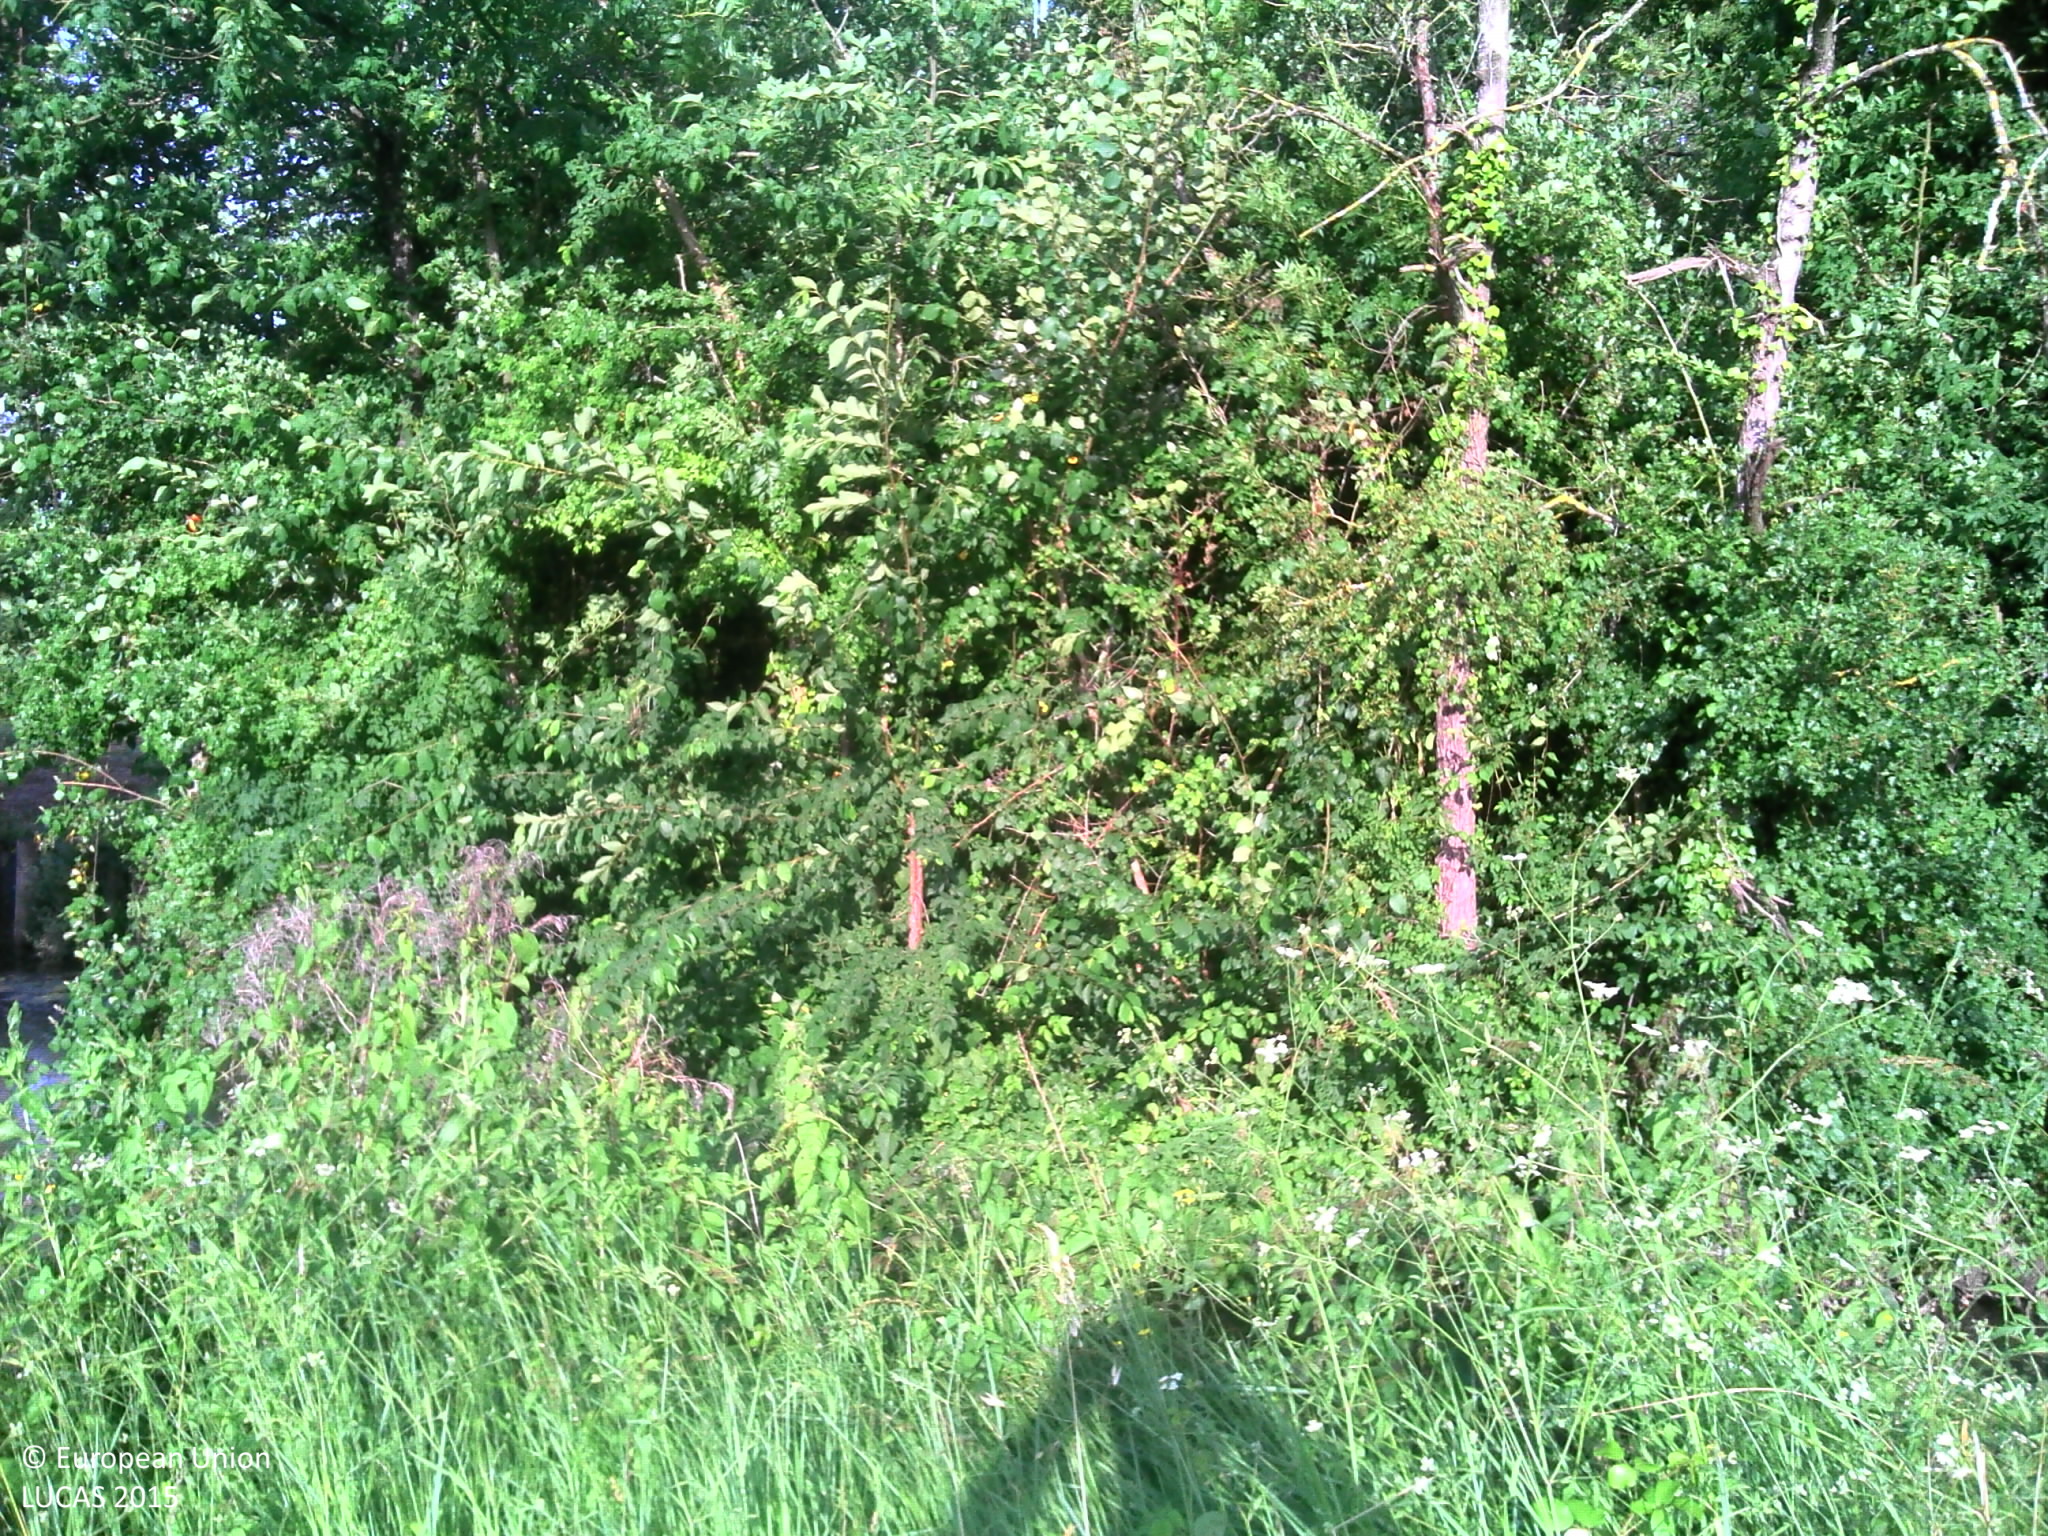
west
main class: Grassland
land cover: Grassland without tree/shrub cover
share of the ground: > 75 %
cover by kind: herbaceous plants 100 %
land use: Agriculture (excluding fallow land and kitchen gardens)
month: June
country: FR
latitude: 46.0418
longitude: -0.9482
